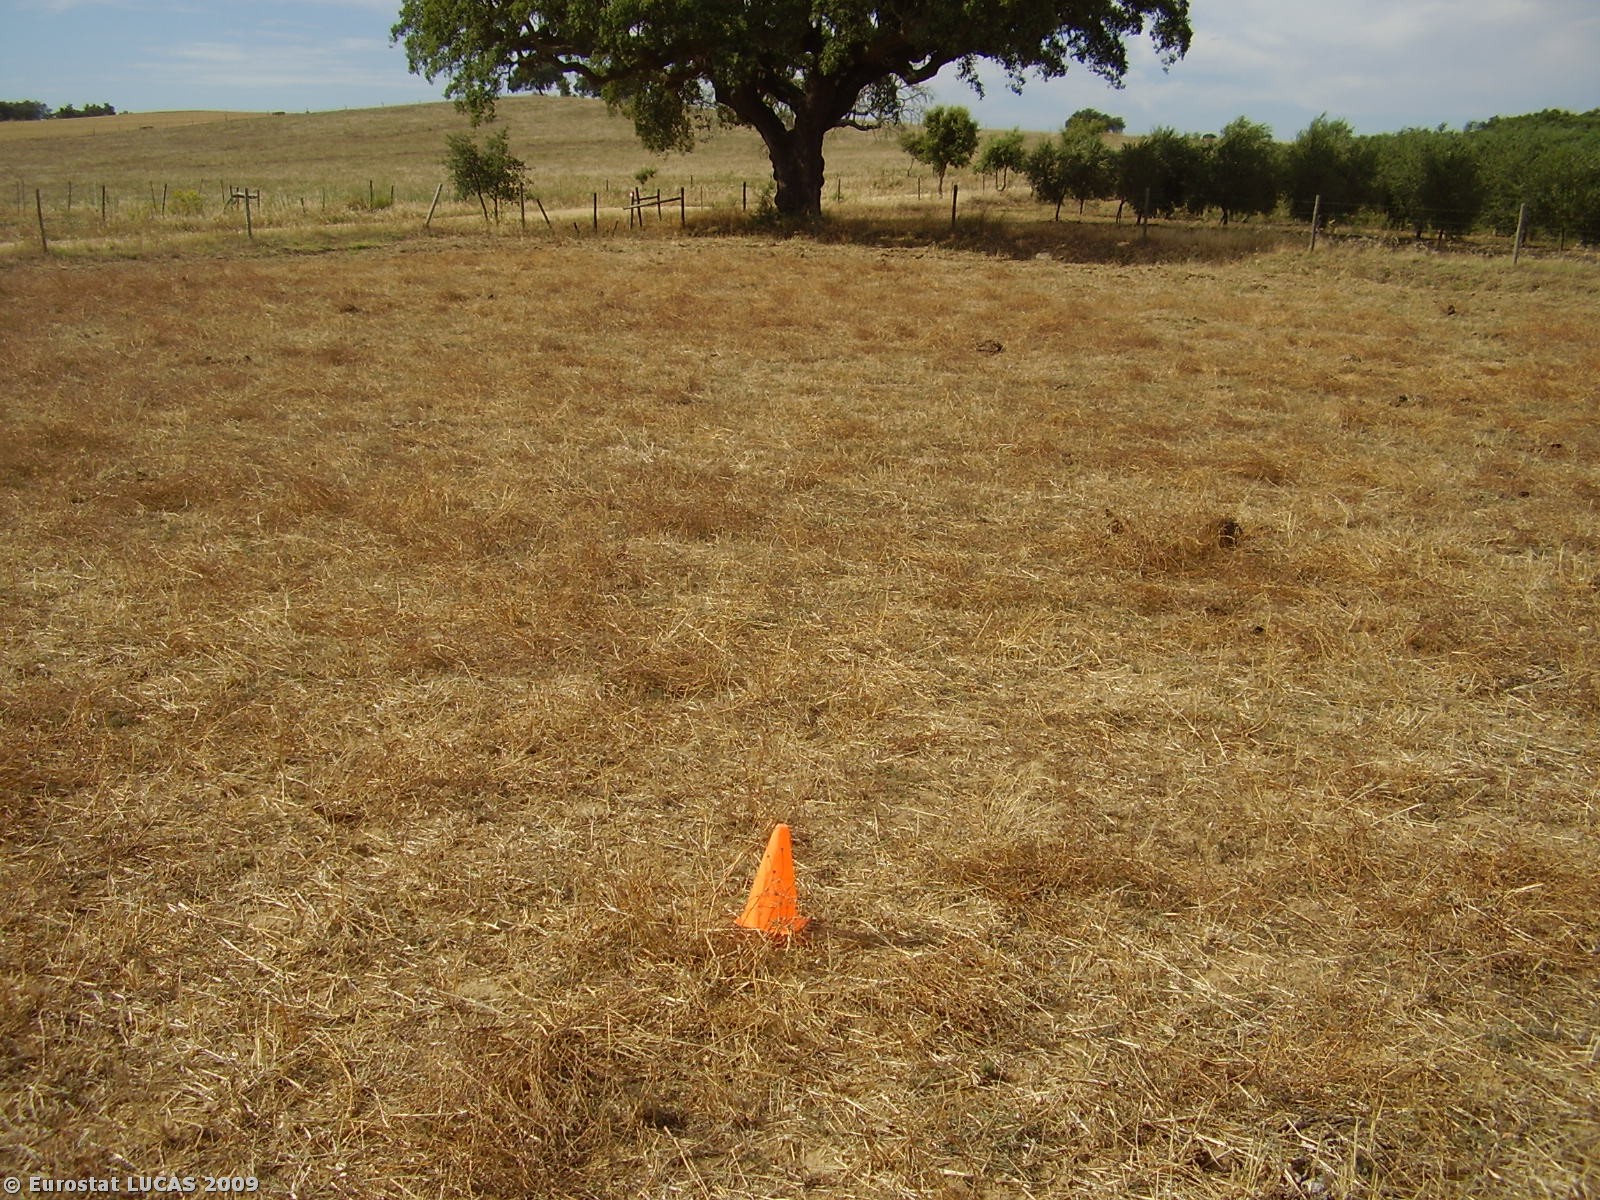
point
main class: Grassland
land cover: Grassland without tree/shrub cover
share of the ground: > 75 %
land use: Agriculture (excluding fallow land and kitchen gardens)
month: July
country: PT
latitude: 38.6895
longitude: -7.8485
